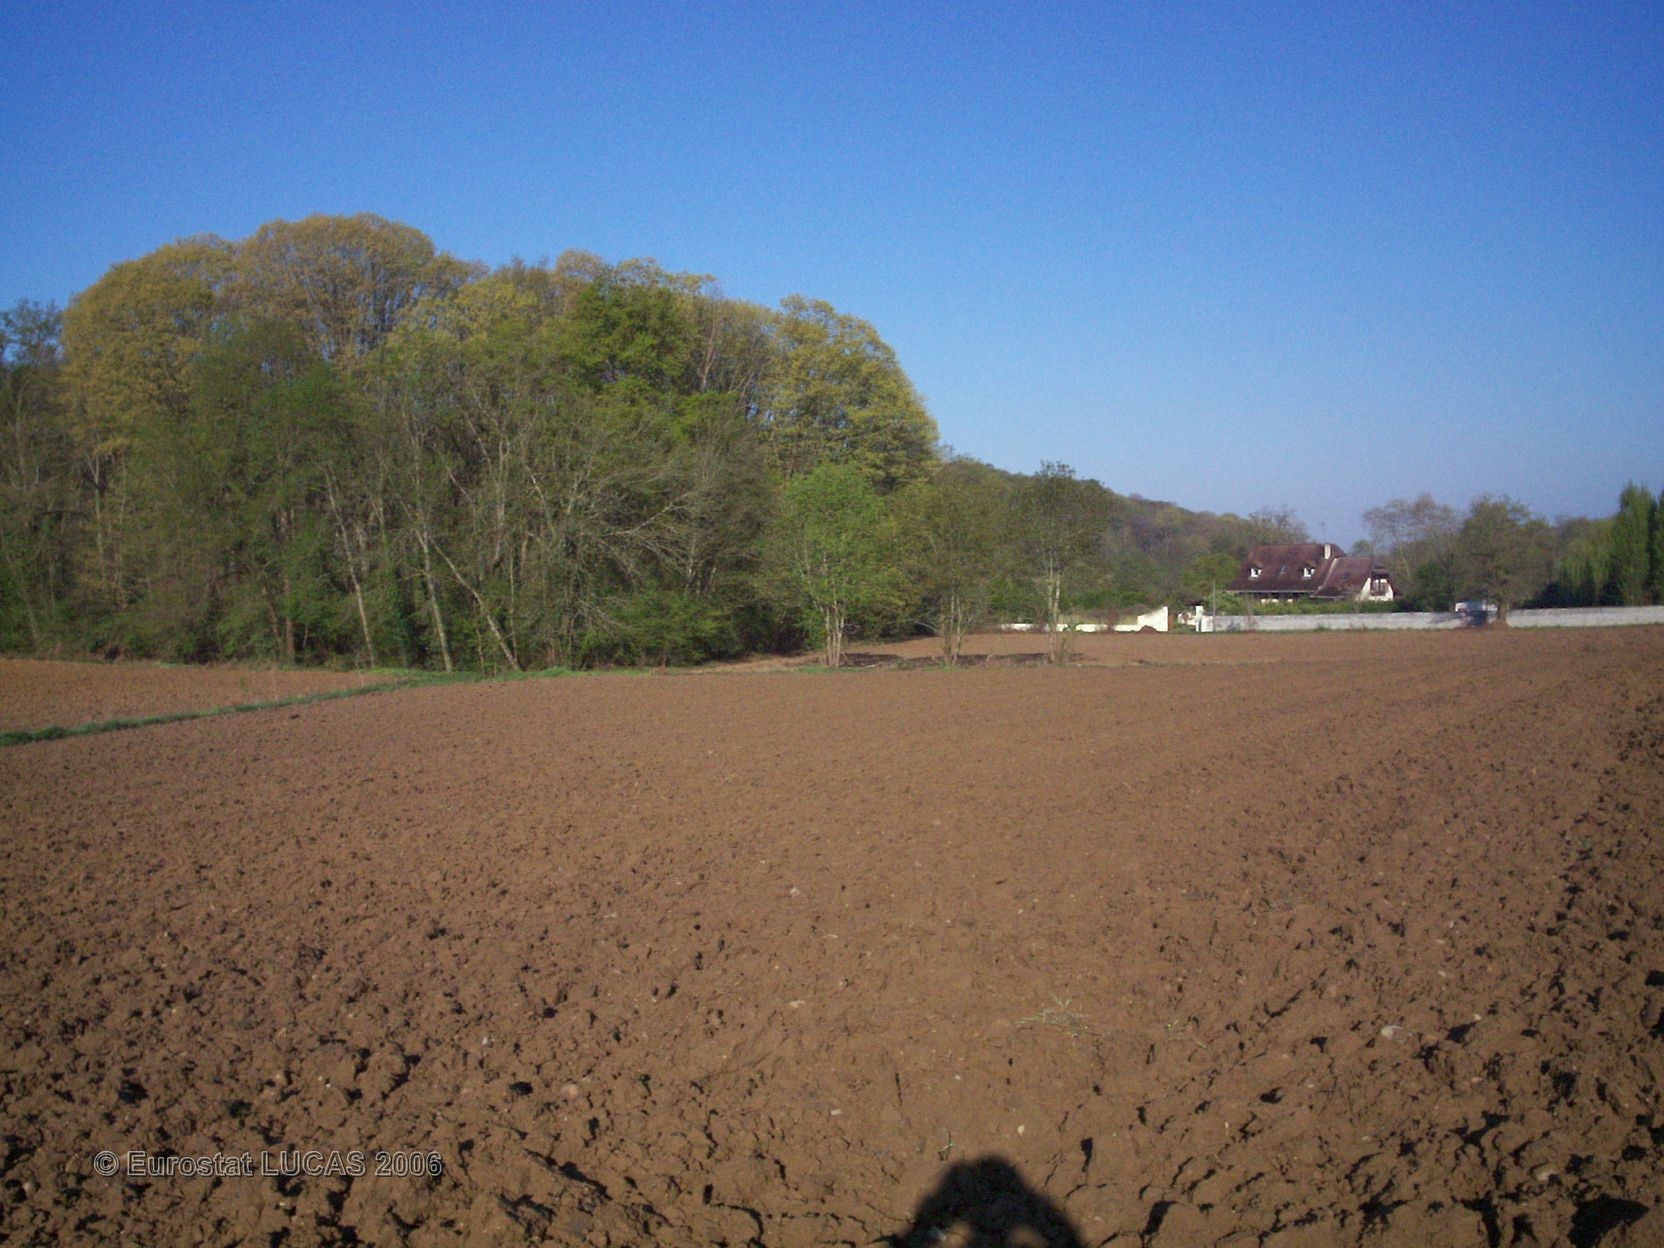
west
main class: Cropland
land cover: Maize
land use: Agriculture (excluding fallow land and kitchen gardens)
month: June
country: FR
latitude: 43.3631
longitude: -0.3103
